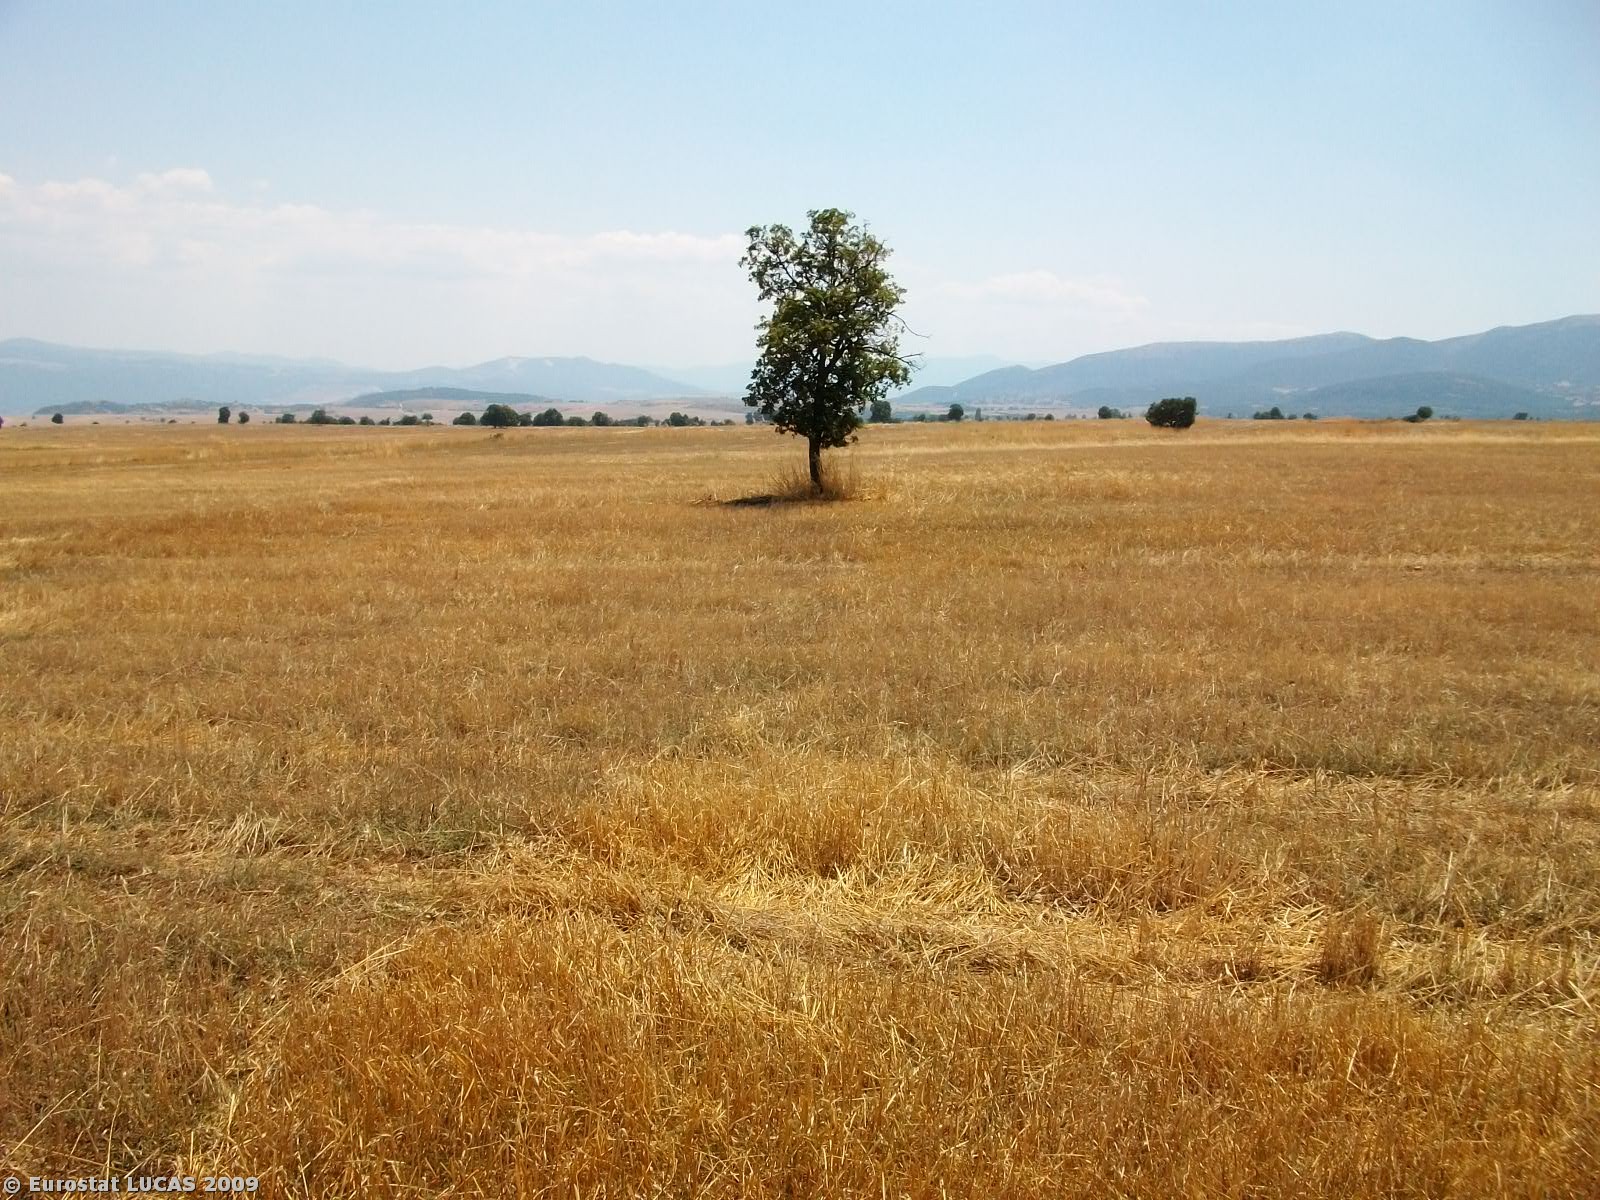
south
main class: Cropland
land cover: Durum wheat
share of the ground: < 10 %
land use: Agriculture (excluding fallow land and kitchen gardens)
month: July
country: GR
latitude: 40.2102
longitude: 21.7991
